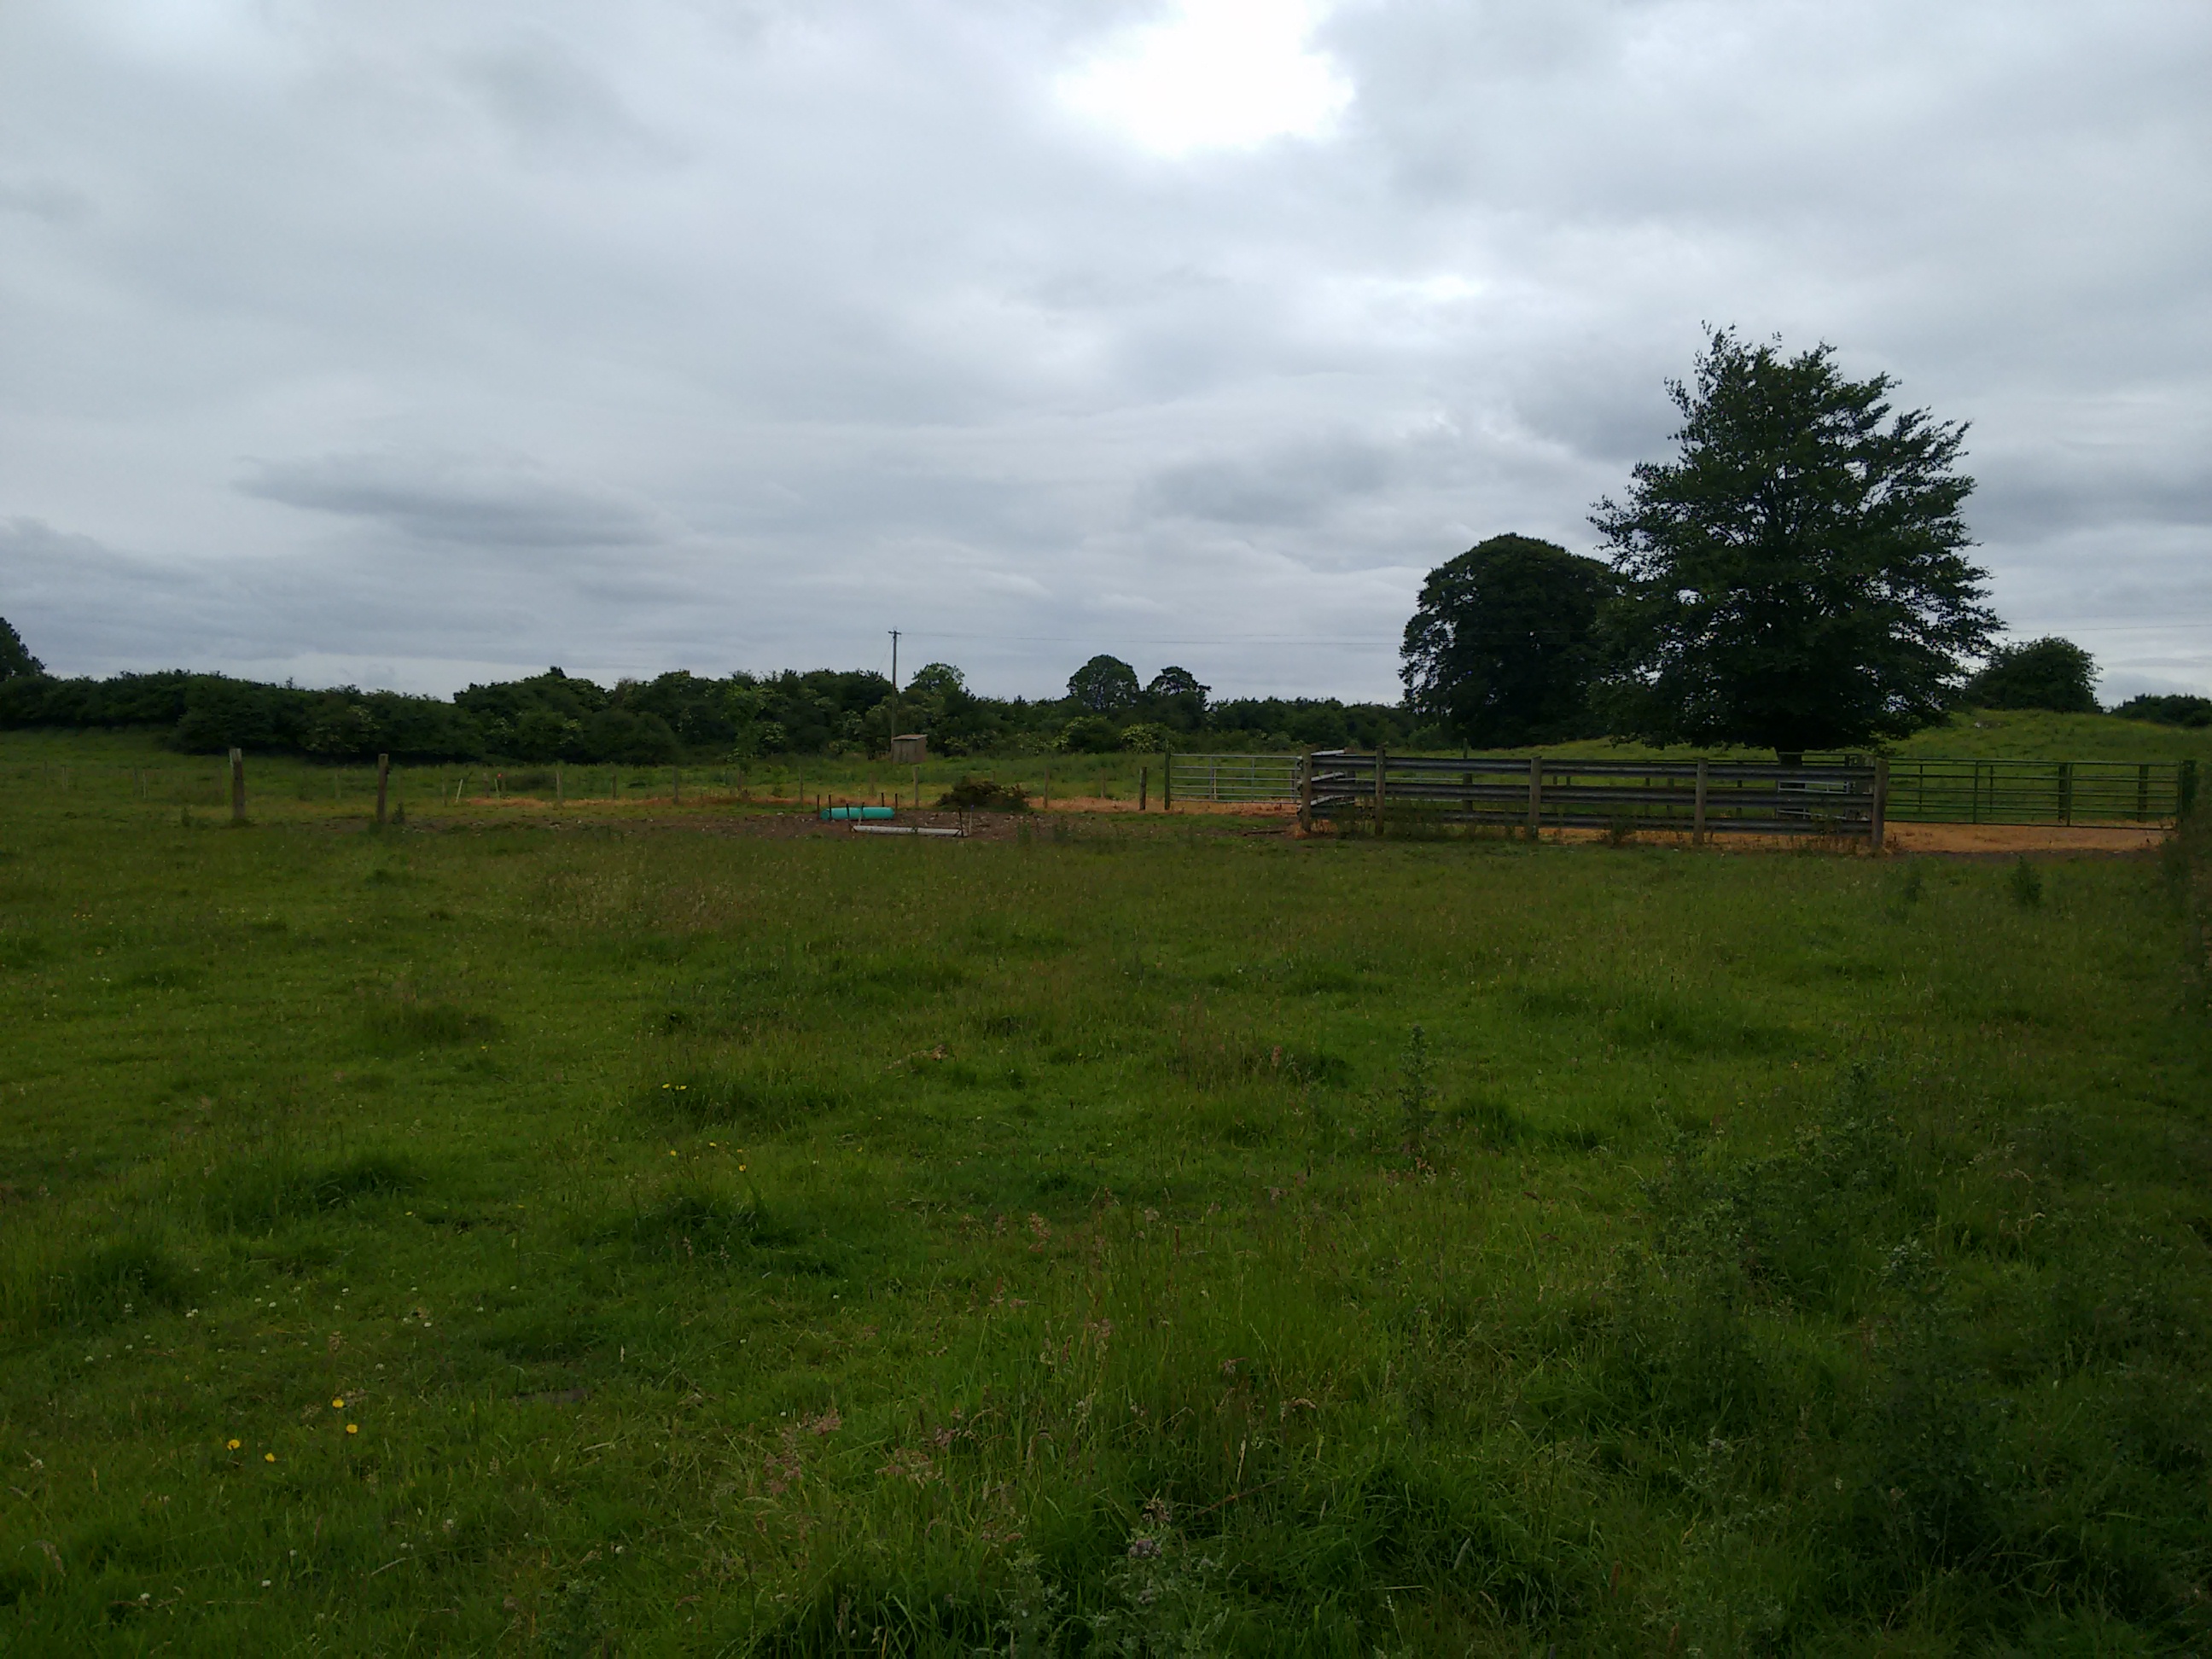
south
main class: Grassland
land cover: Grassland without tree/shrub cover
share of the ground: > 75 %
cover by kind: herbaceous plants 100 %
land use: Agriculture (excluding fallow land and kitchen gardens)
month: June
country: IE
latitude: 53.4070
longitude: -7.5957
